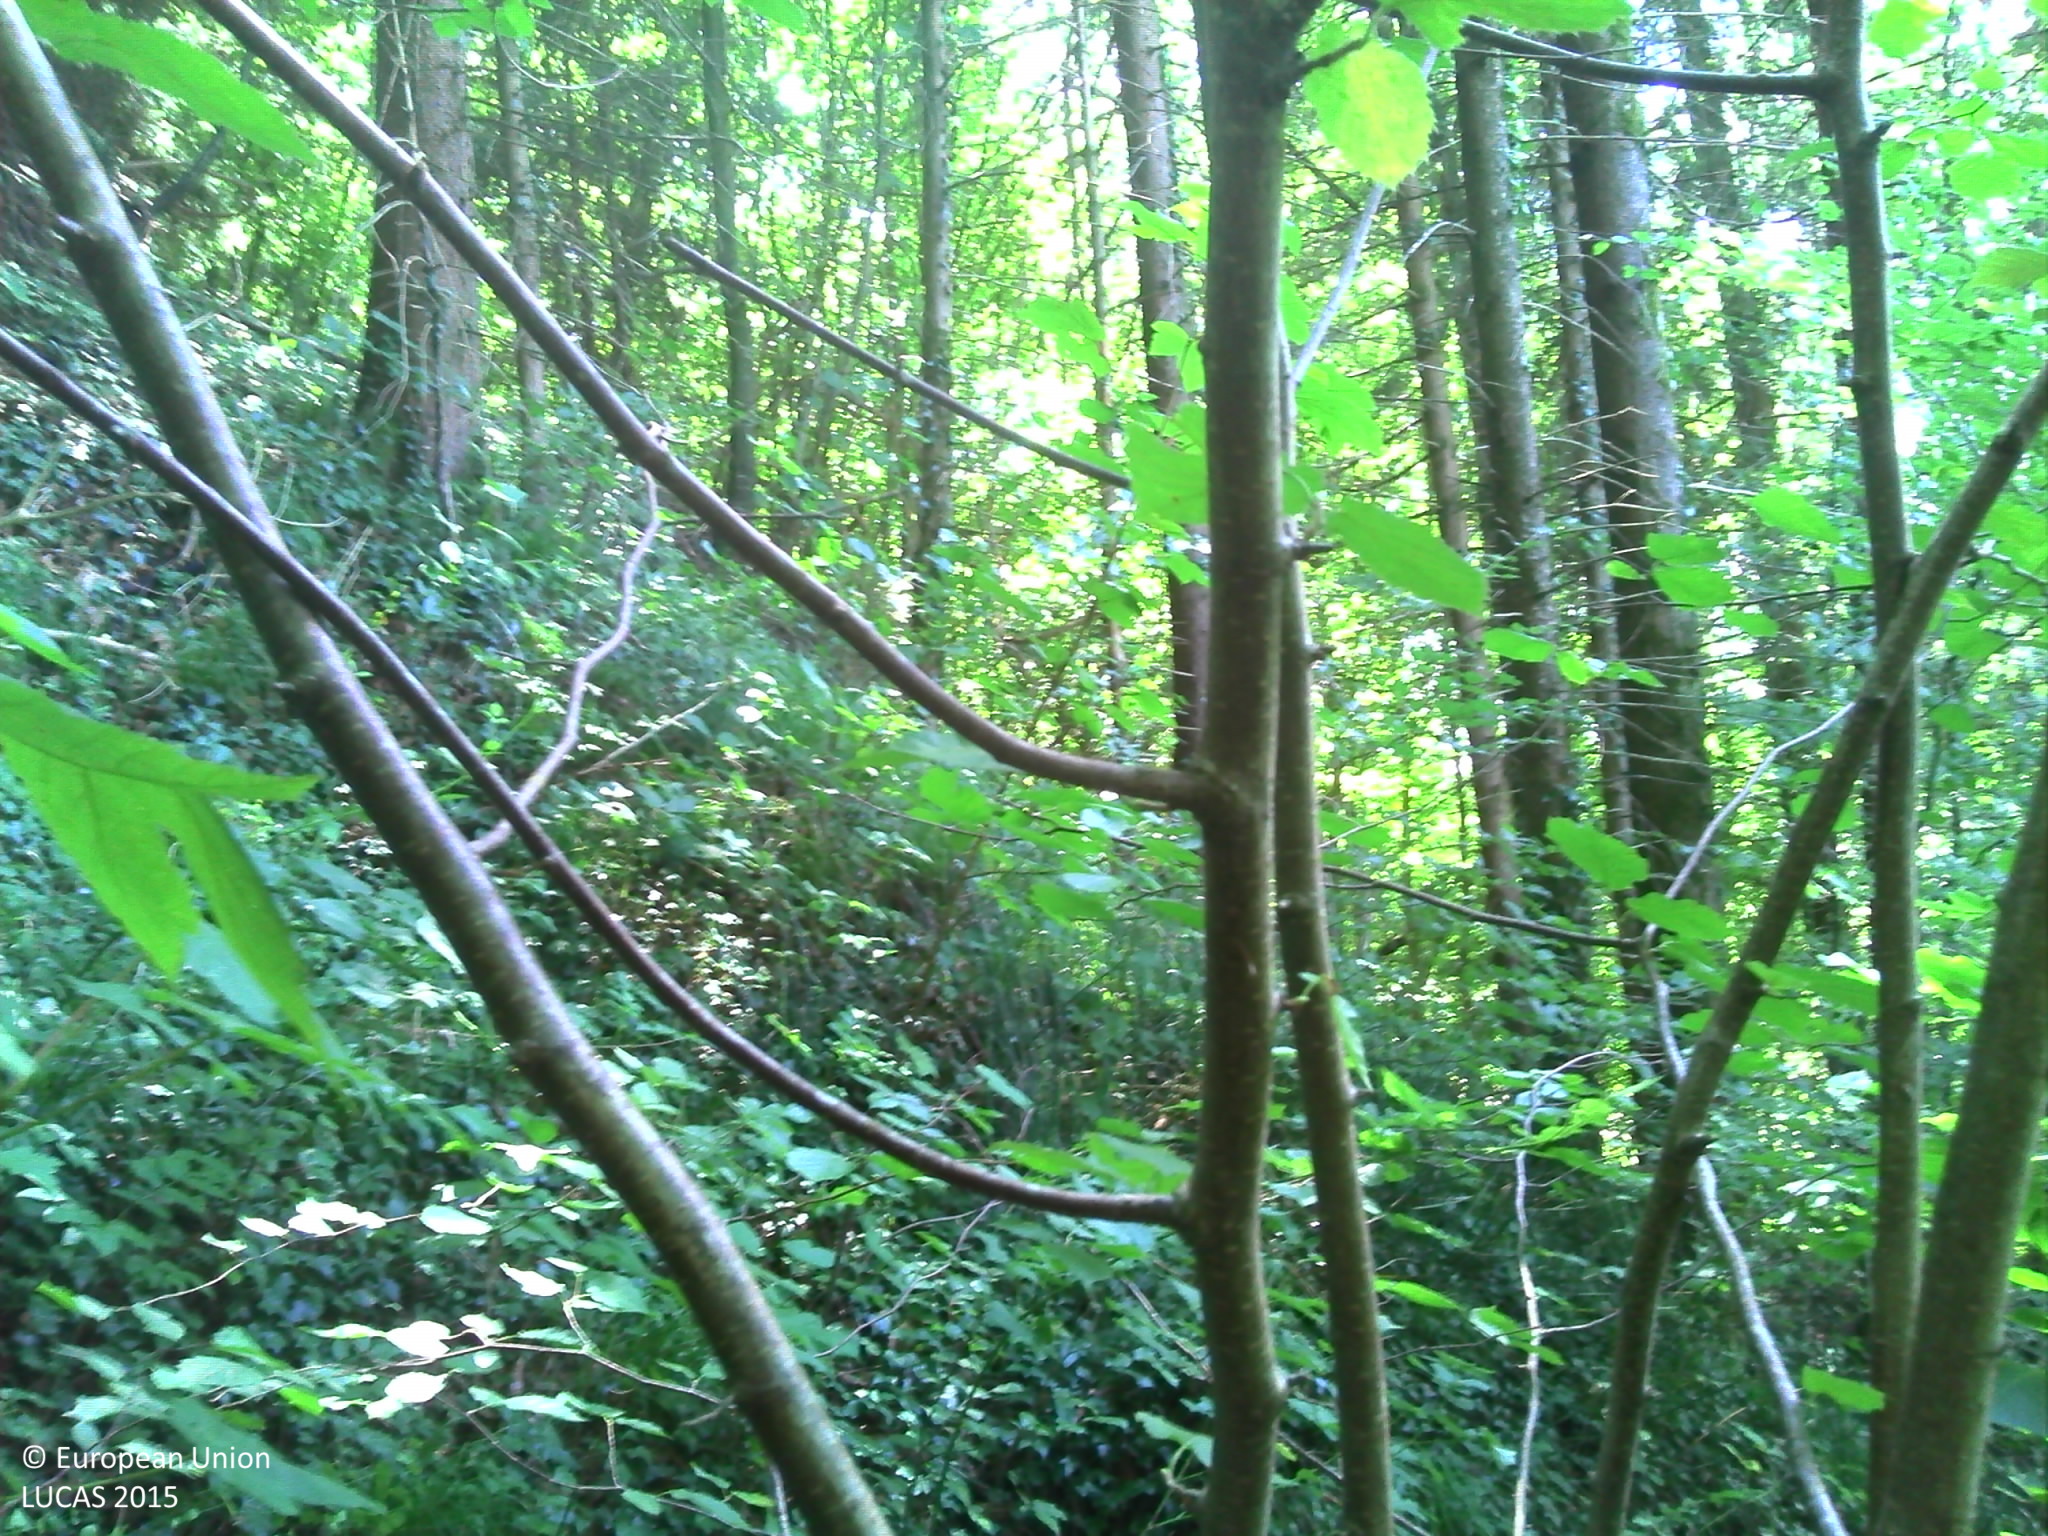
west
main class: Woodland
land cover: Spruce dominated mixed woodland
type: mountainous beech forest
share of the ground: > 75 %
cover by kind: broadleaved forest trees 40 %, coniferous forest trees 35 %, herbaceous plants 20 %, lichens and mosses 5 %
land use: Forestry
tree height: > 5 m
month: July
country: FR
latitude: 45.9562
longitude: 6.1203
